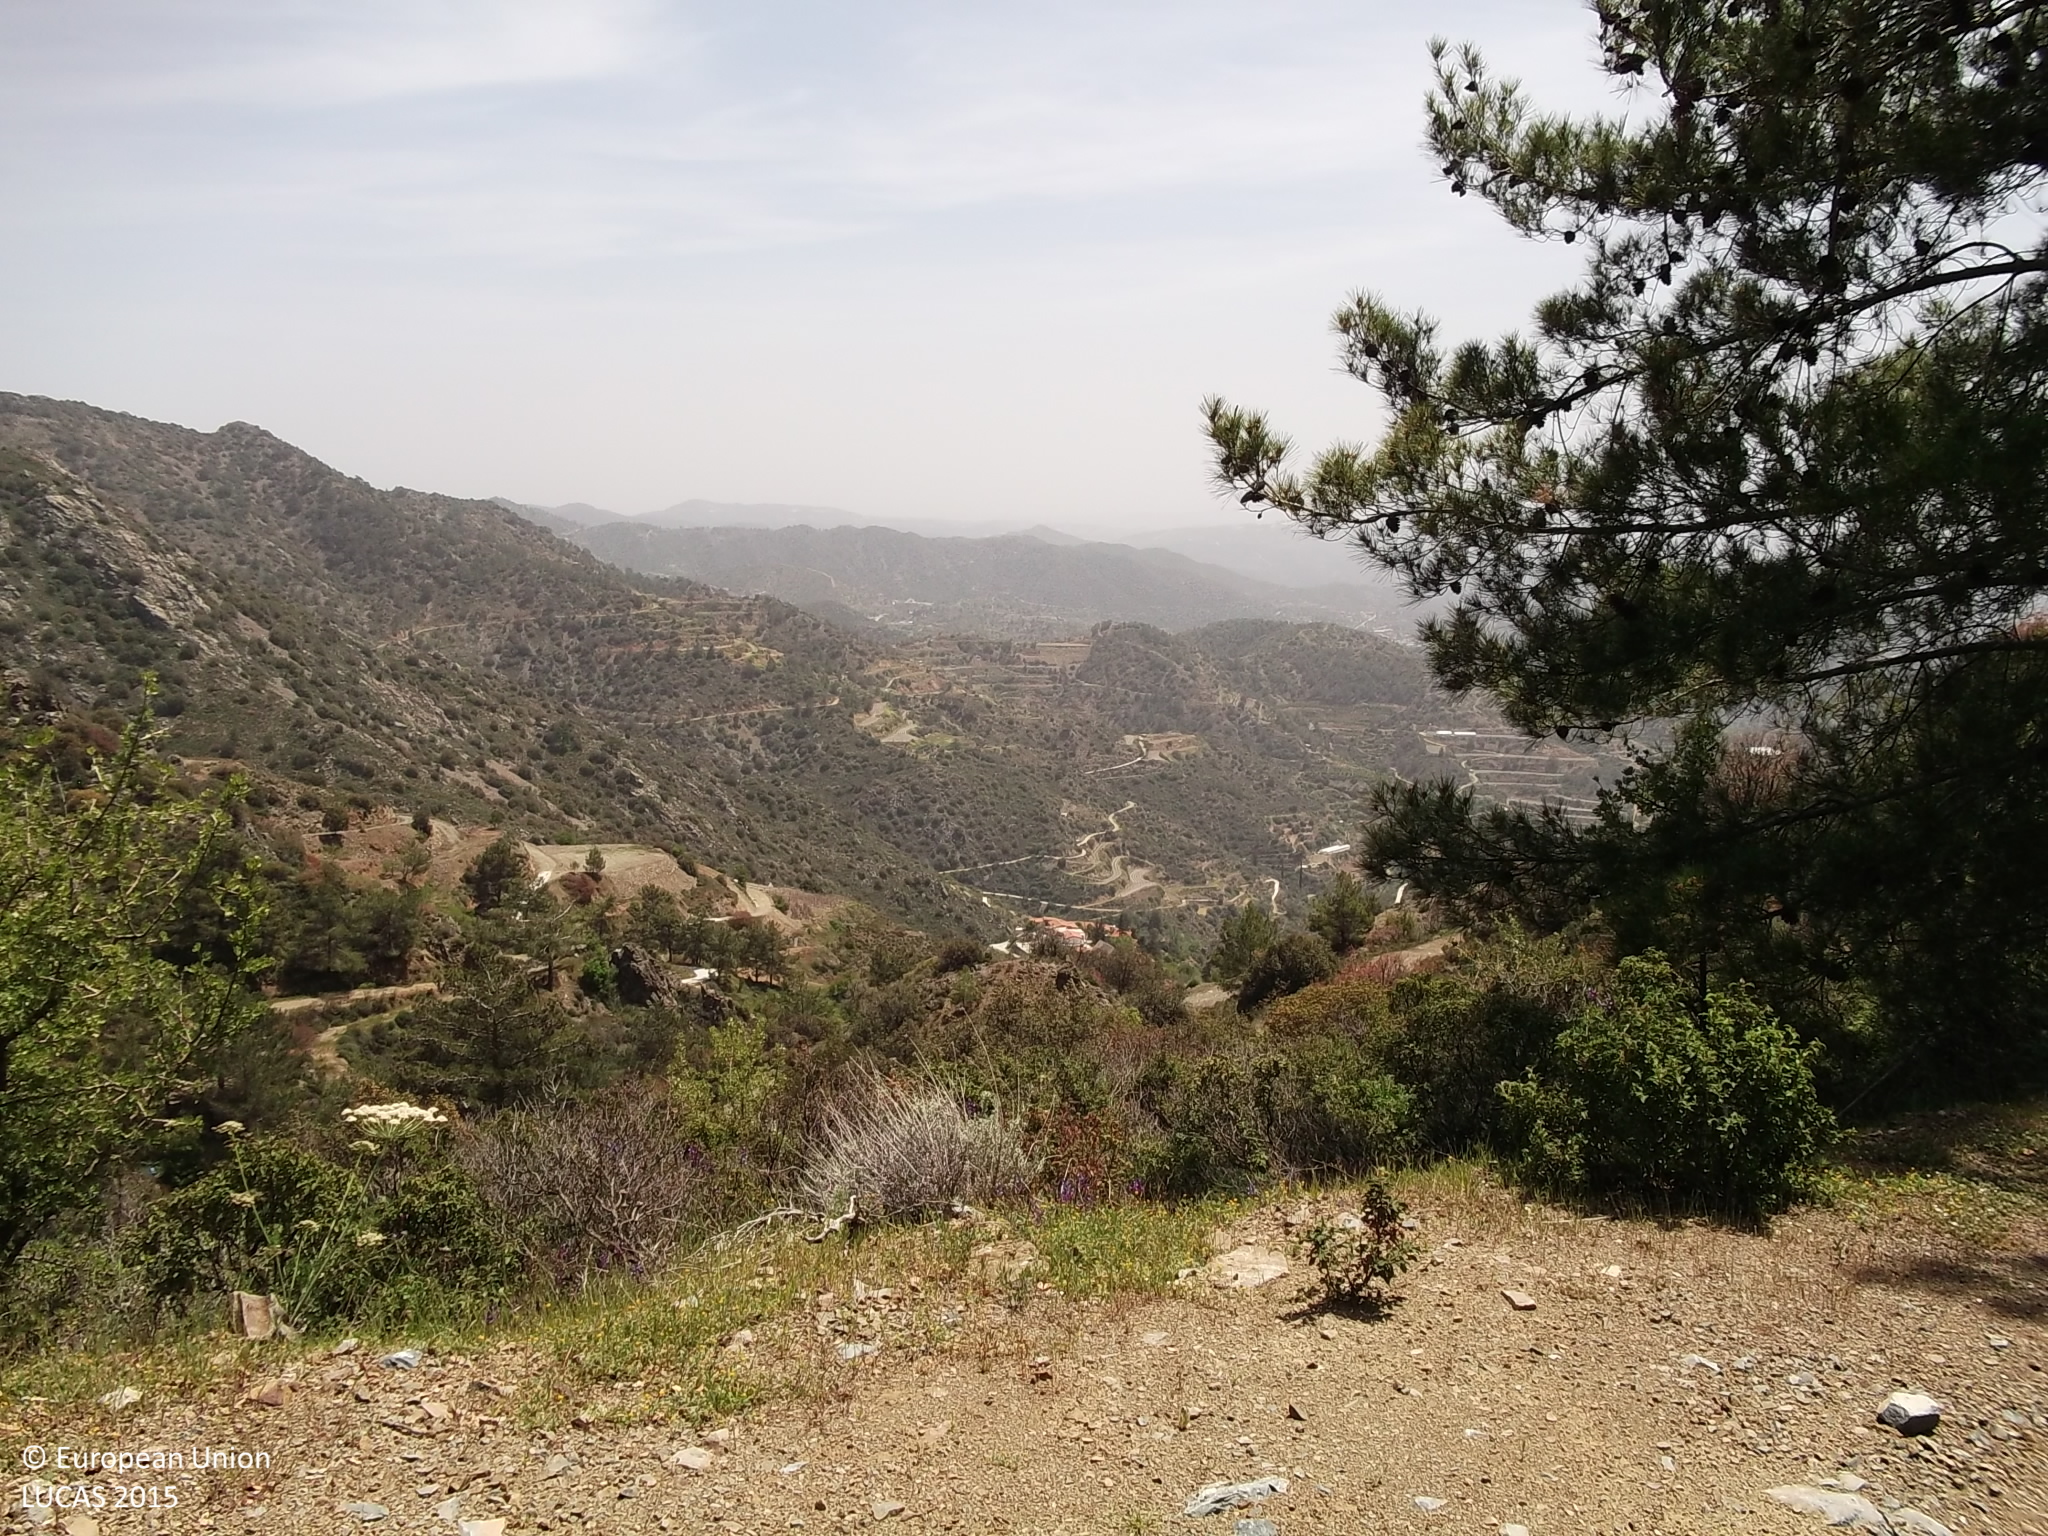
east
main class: Shrubland
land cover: Shrubland with sparse tree cover
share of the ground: > 75 %
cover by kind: shrubs 85 %, unconsolidated bare surface 10 %, broadleaved forest trees 5 %
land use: Semi-natural and natural areas not in use
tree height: > 5 m
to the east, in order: Shrubland with sparse tree cover; Tracks; Electric lines; Dry stone walls; Shrubland with sparse tree cover; Tracks; Dry stone walls; Shrubland with sparse tree cover; Tracks; Dry stone walls; Shrubland without tree cover; Dry stone walls; Shrubland without tree cover; Dry stone walls; Shrubland without tree cover; Dry stone walls; Shrubland without tree cover; Dry stone walls; Tracks; Shrubland with sparse tree cover; Tracks; Dry stone walls; Pine dominated mixed woodland; Tracks; Pine dominated mixed woodland
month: April
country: CY
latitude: 34.8886
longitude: 33.1429
